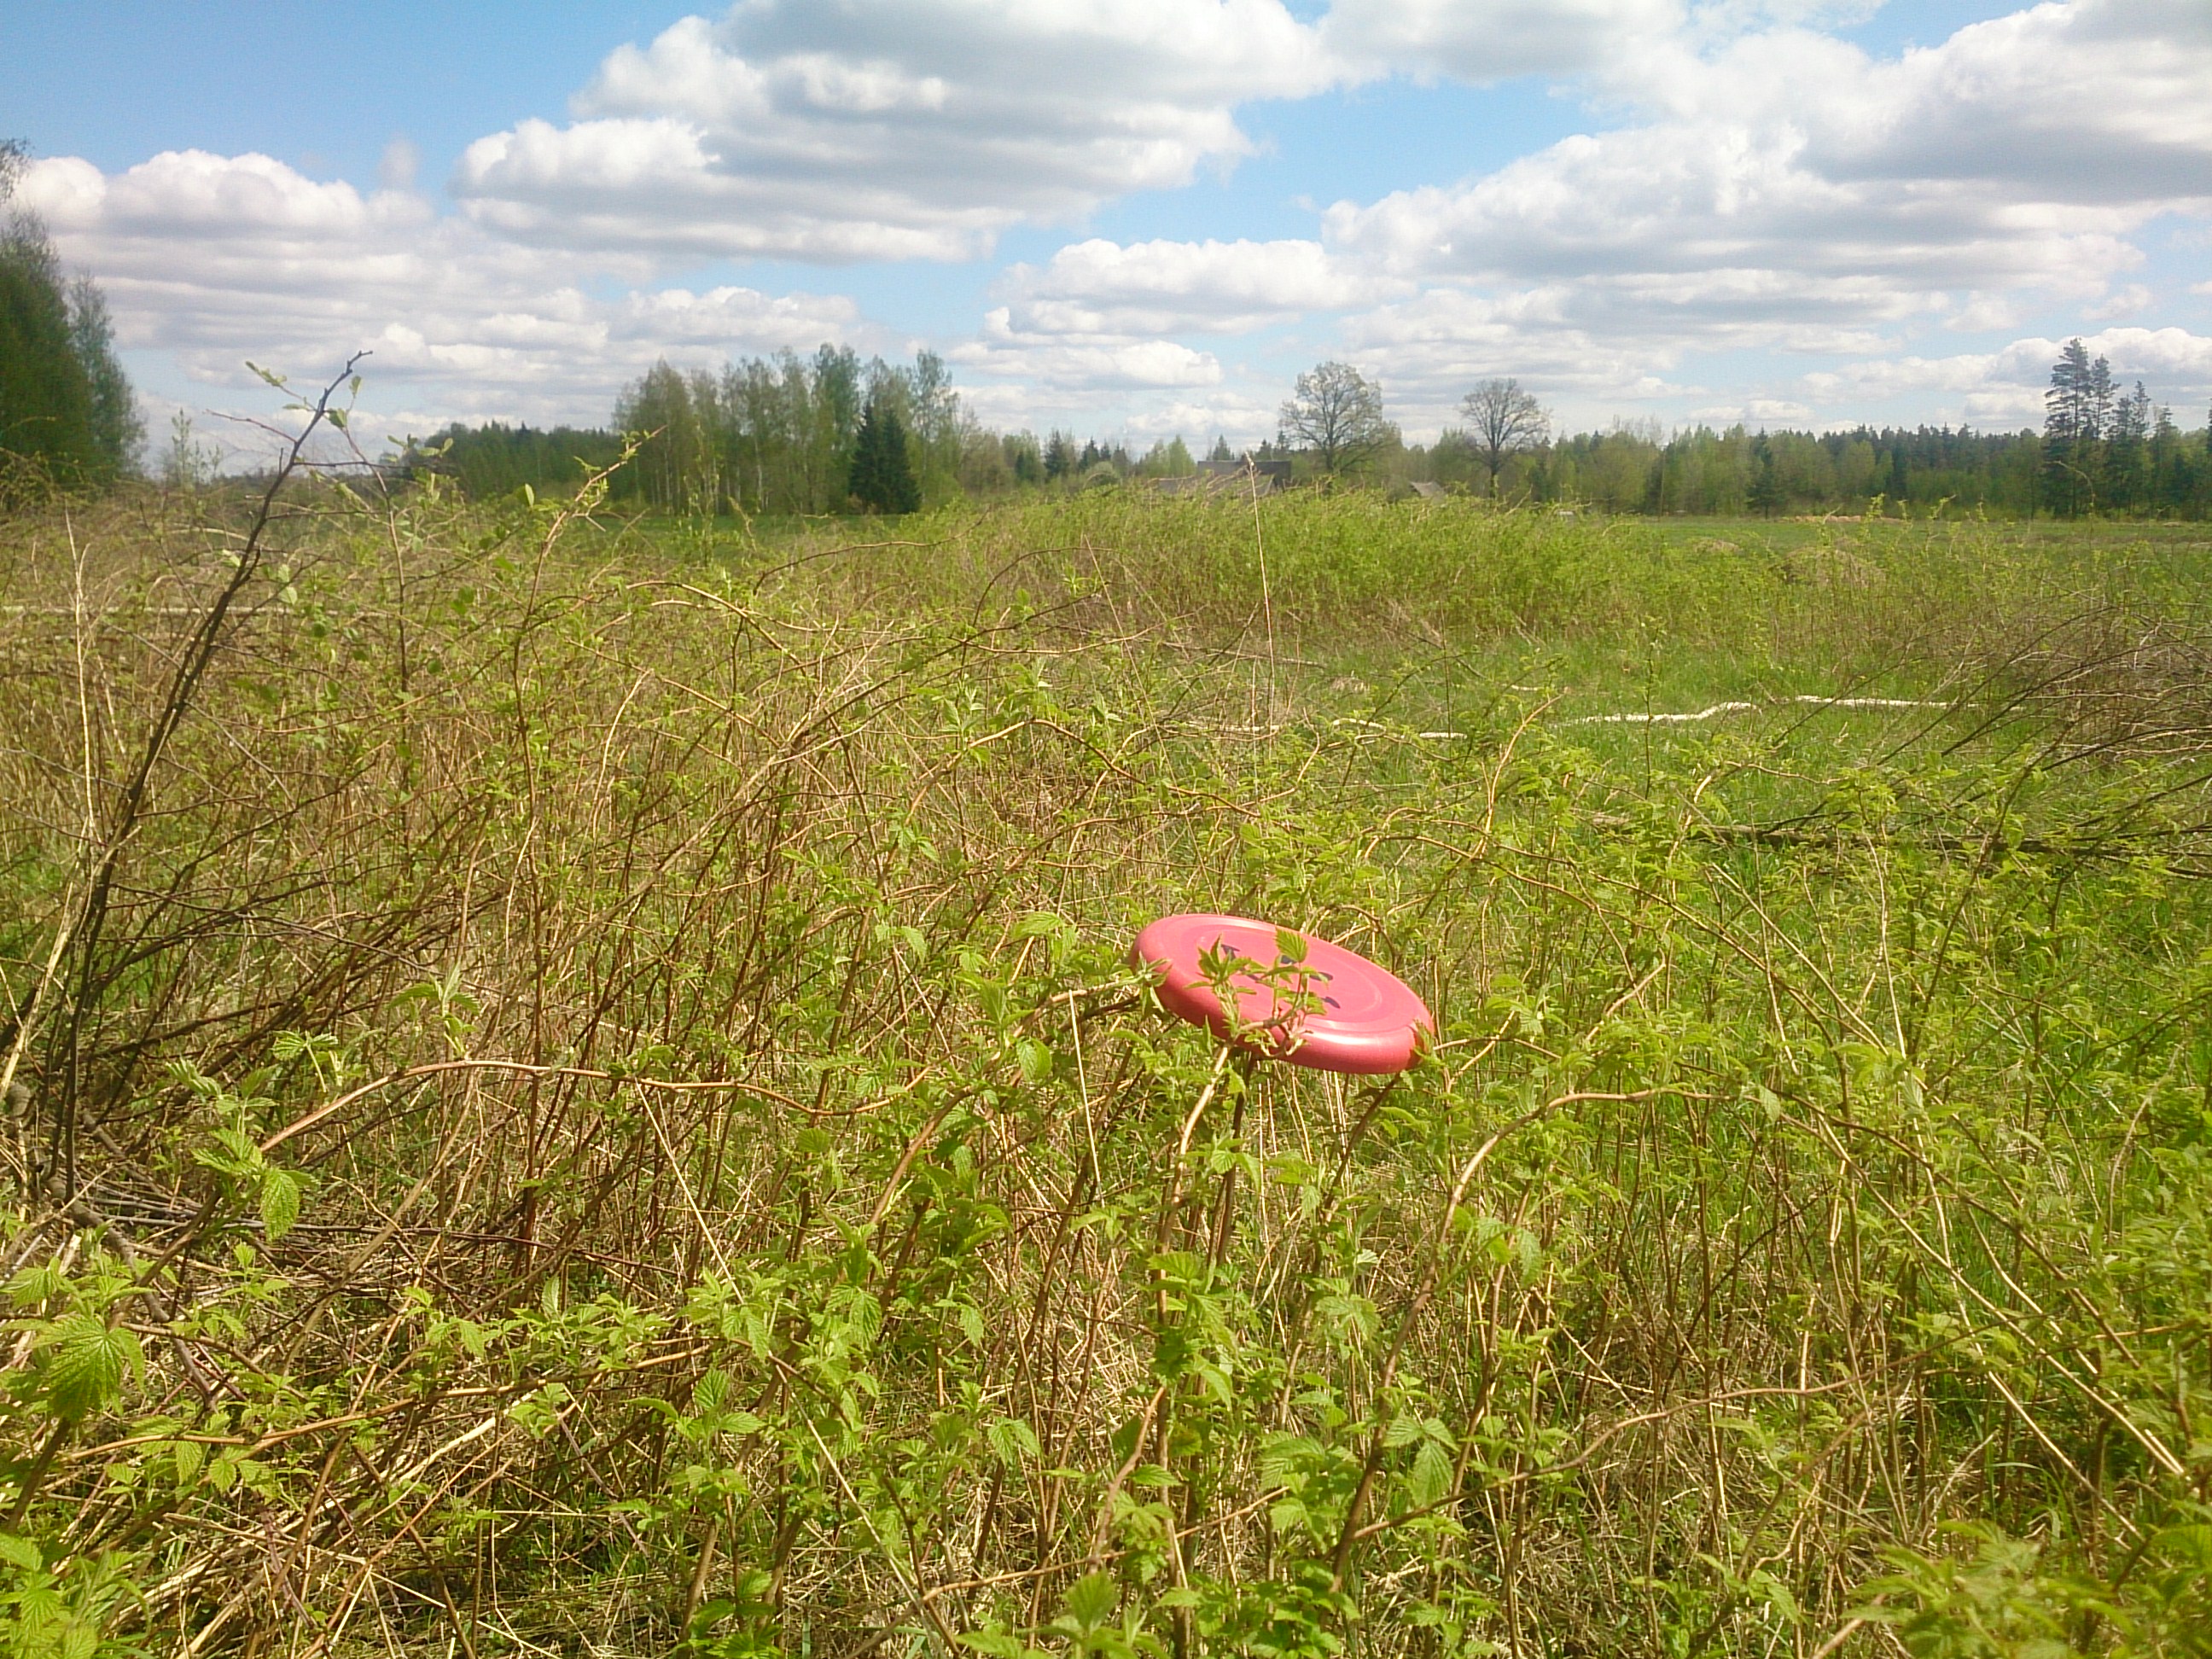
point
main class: Shrubland
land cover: Shrubland without tree cover
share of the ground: > 75 %
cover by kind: shrubs 90 %, herbaceous plants 10 %
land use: Abandoned areas
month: May
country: LV
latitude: 56.7603
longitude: 24.0712
